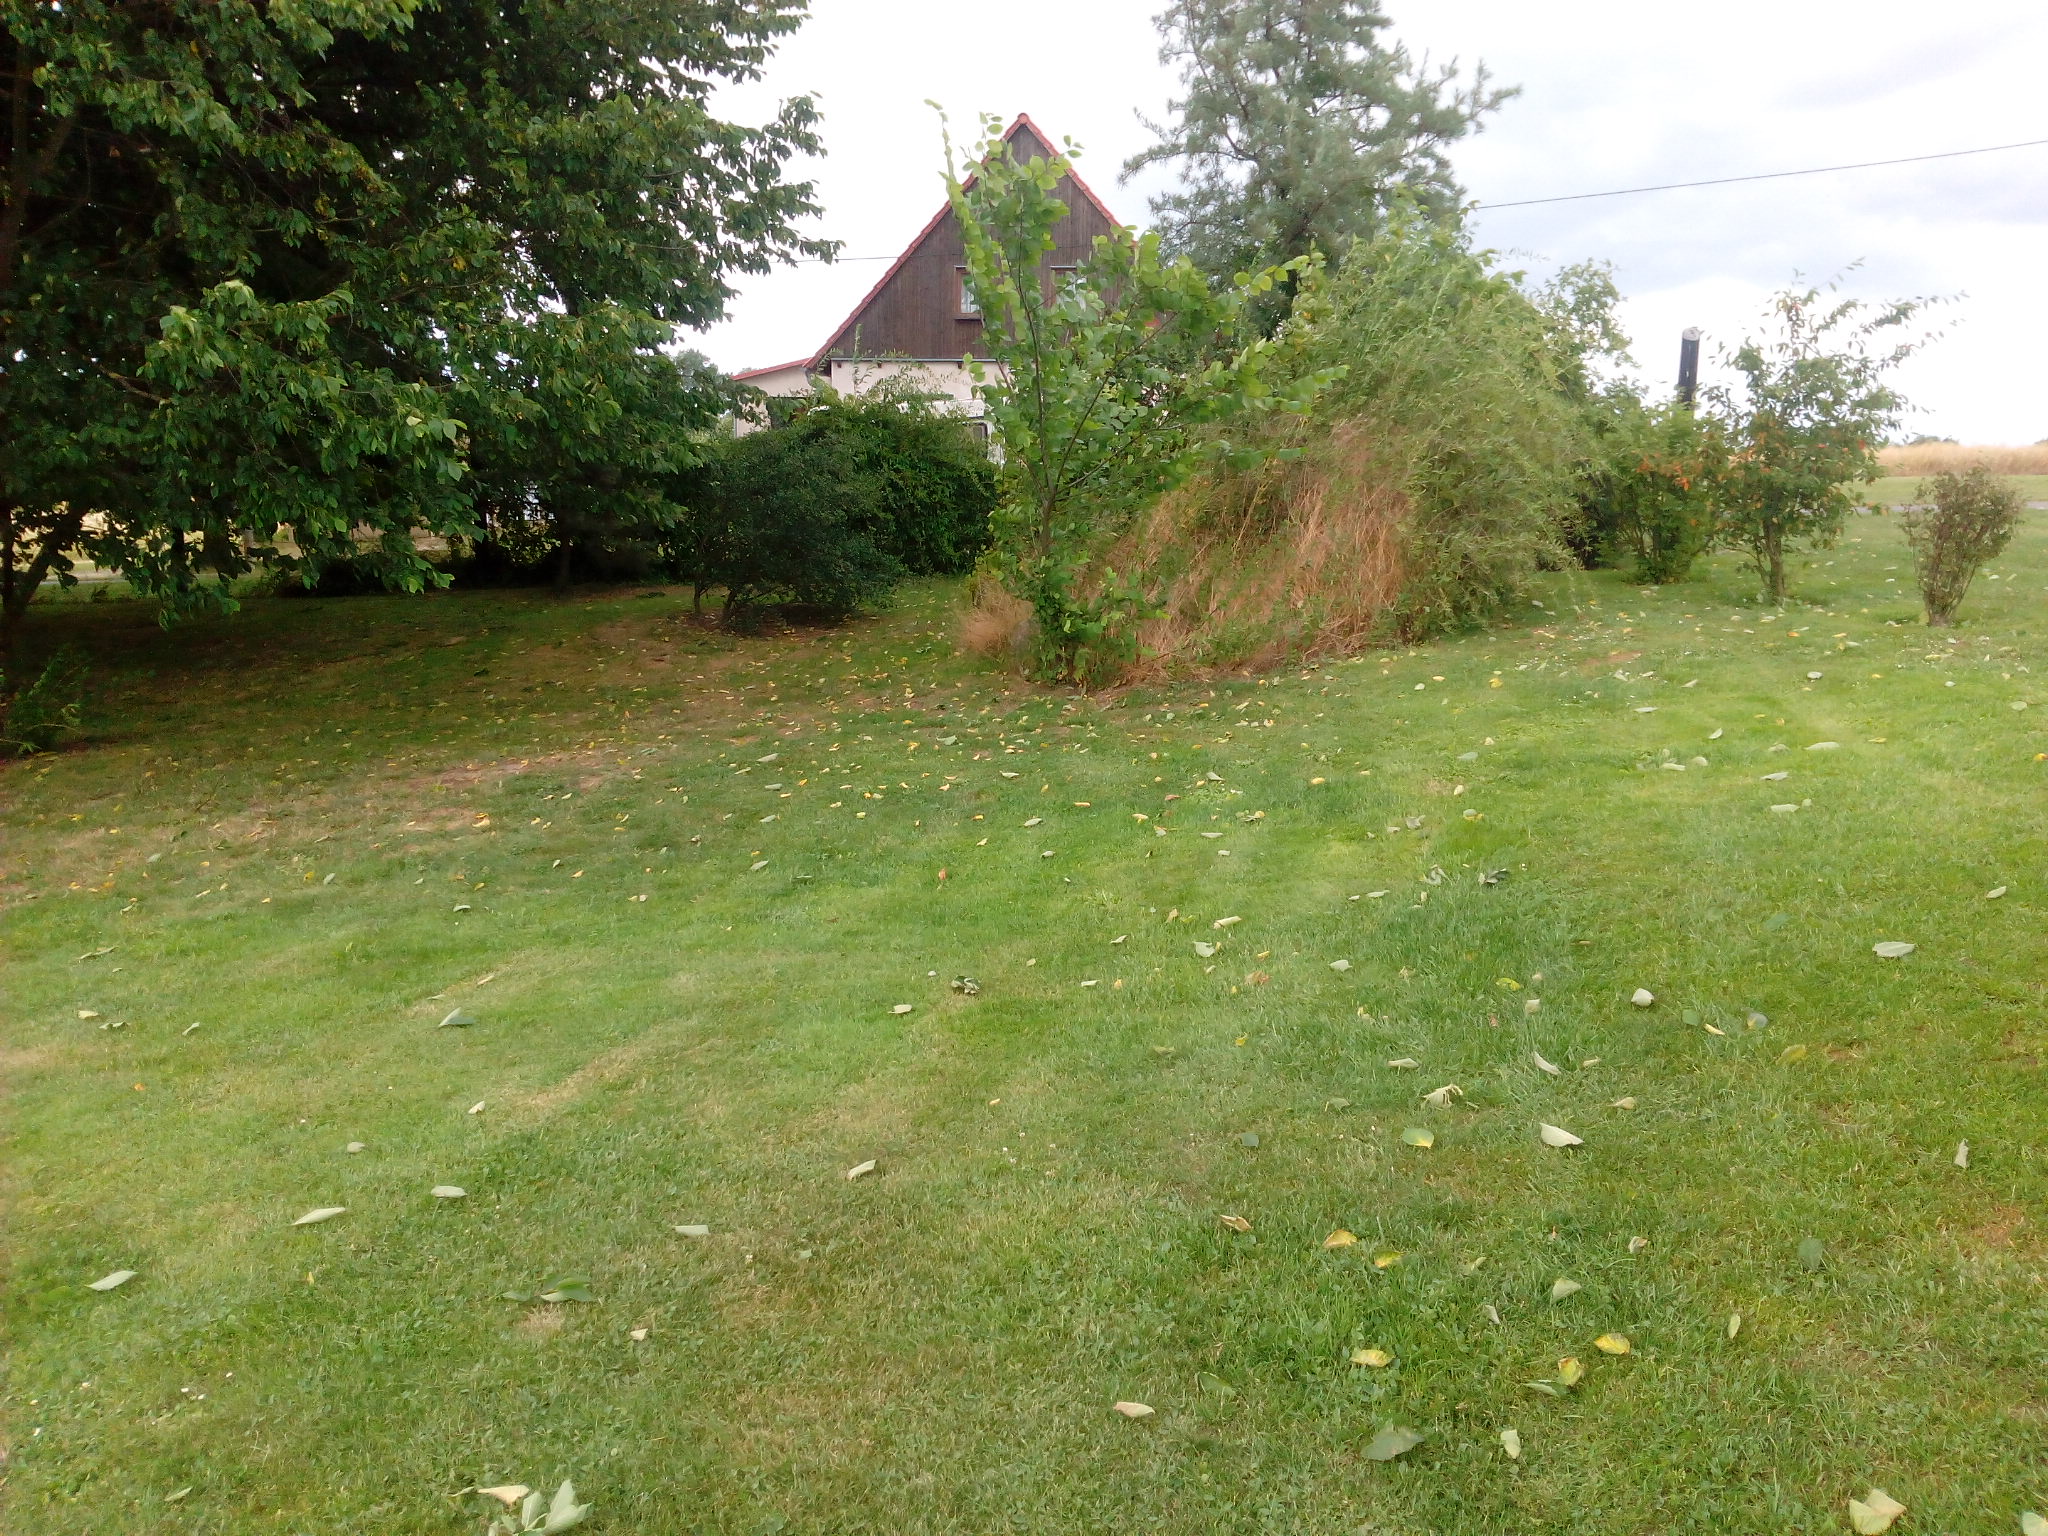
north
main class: Grassland
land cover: Grassland with sparse tree/shrub cover
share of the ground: > 75 %
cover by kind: herbaceous plants 95 %, broadleaved forest trees 5 %
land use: Residential
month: July
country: DE
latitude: 53.3264
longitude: 14.2798
